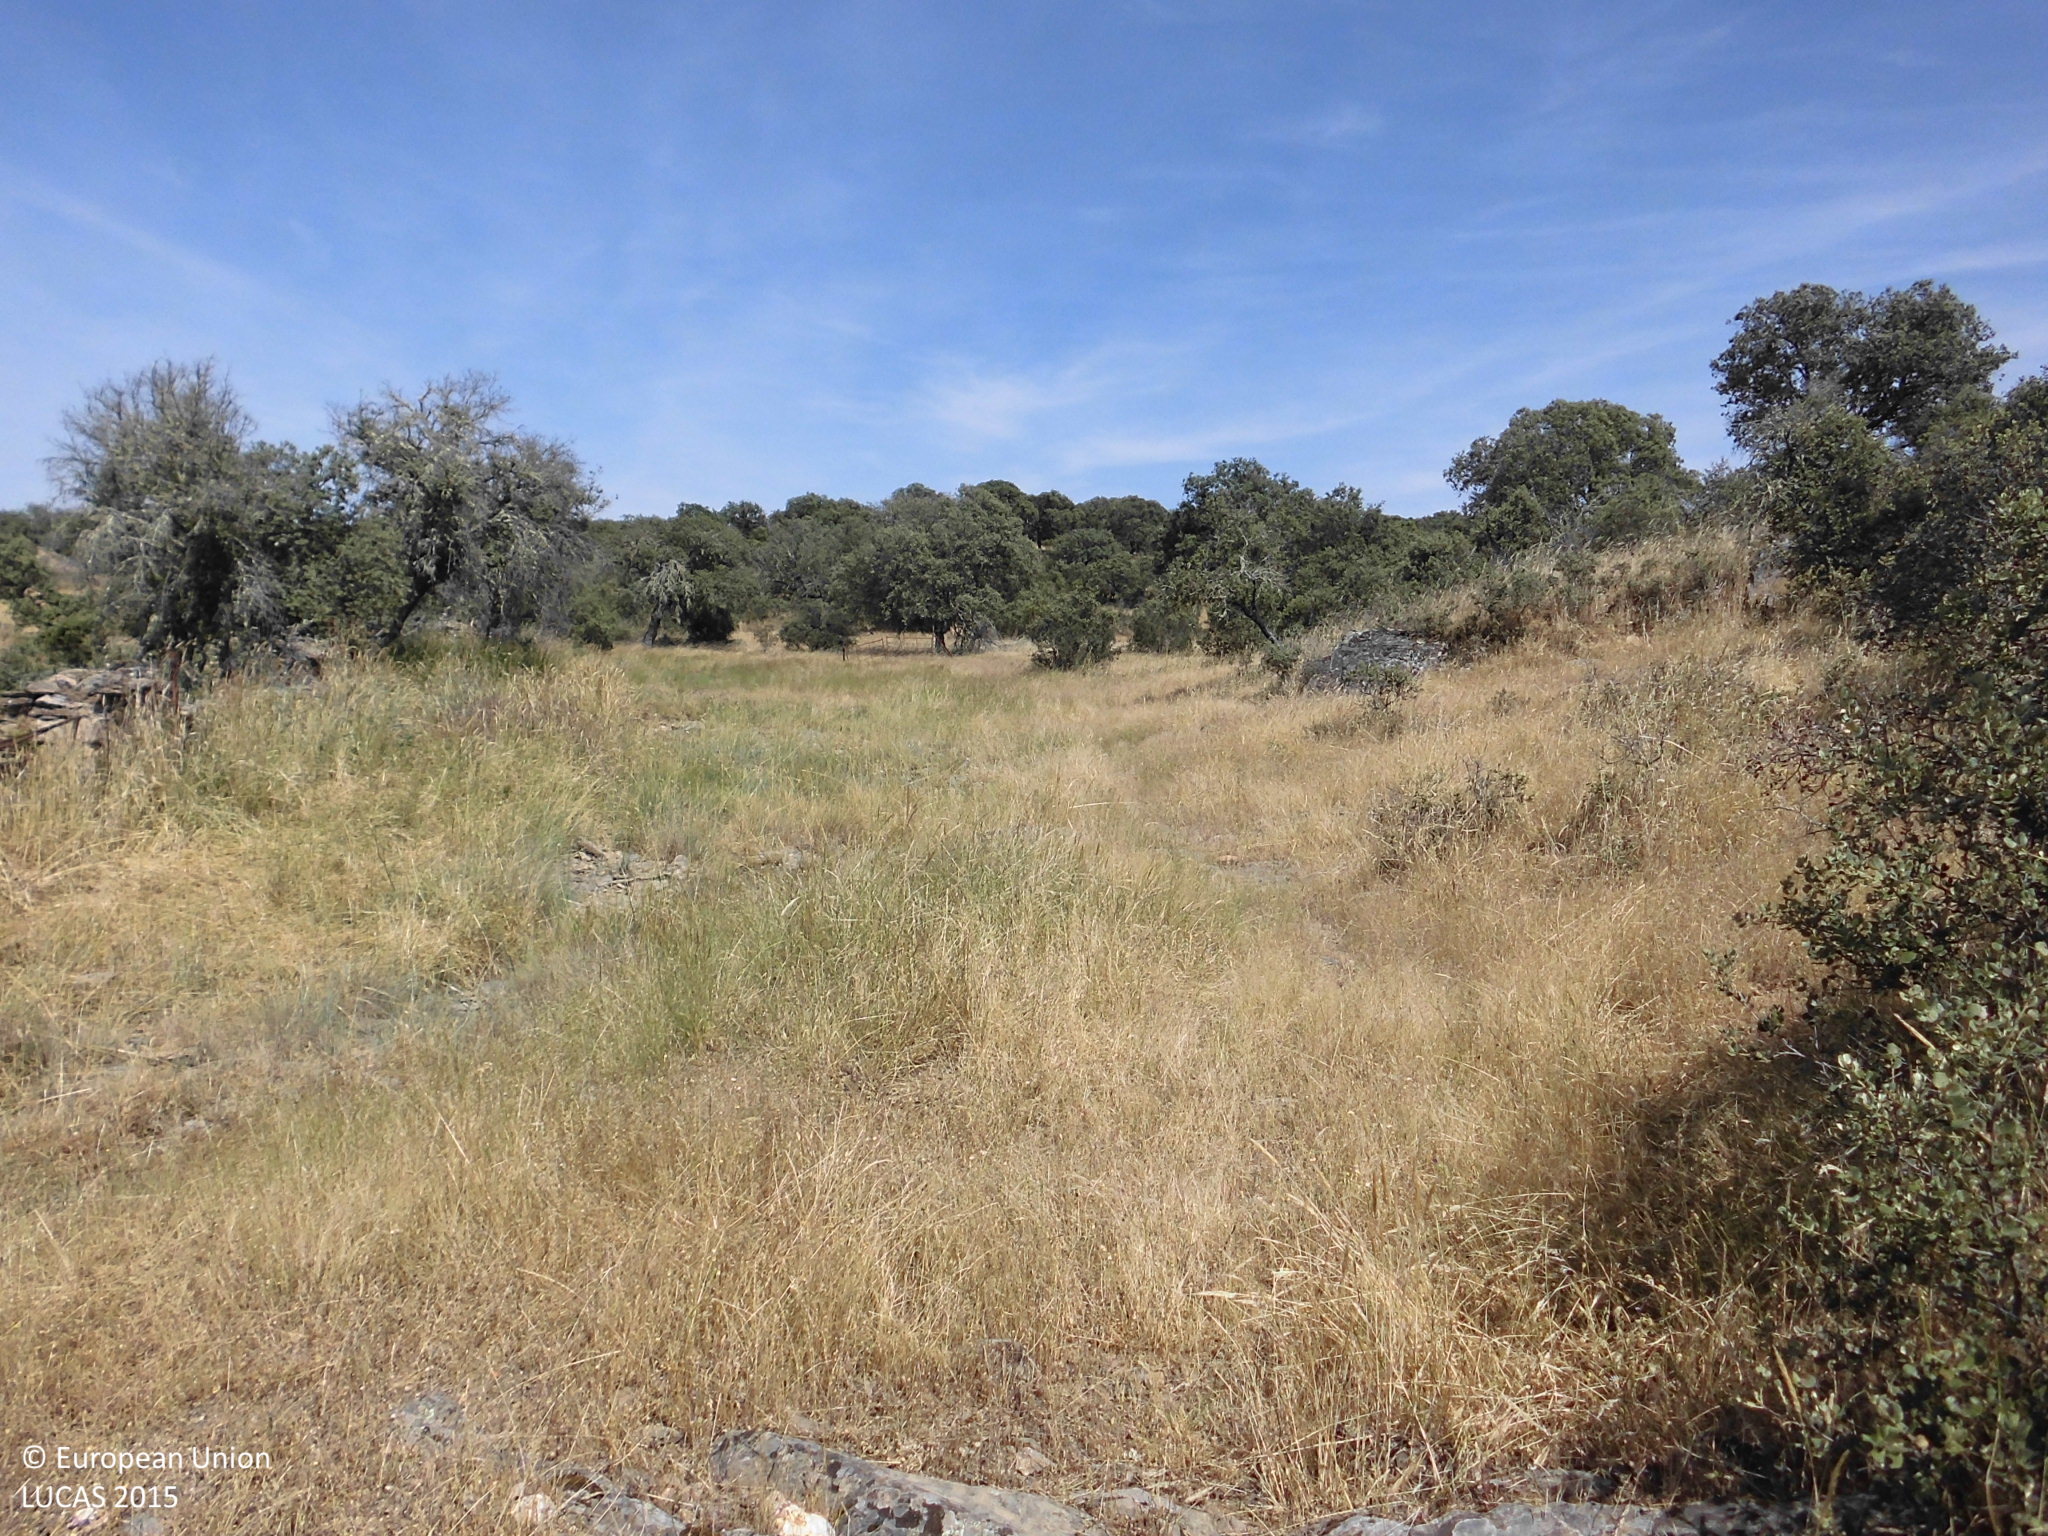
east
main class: Shrubland
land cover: Shrubland with sparse tree cover
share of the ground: 25 - 50 %
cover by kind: shrubs 40 %, herbaceous plants 30 %, unconsolidated bare surface 25 %, broadleaved forest trees 5 %
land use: Forestry
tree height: < 5 m
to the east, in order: Shrubland with sparse tree cover; Rivers and streams; Shrubland with sparse tree cover; Fences; Broadleaved woodland
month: May
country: ES
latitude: 39.4532
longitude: -6.0402
